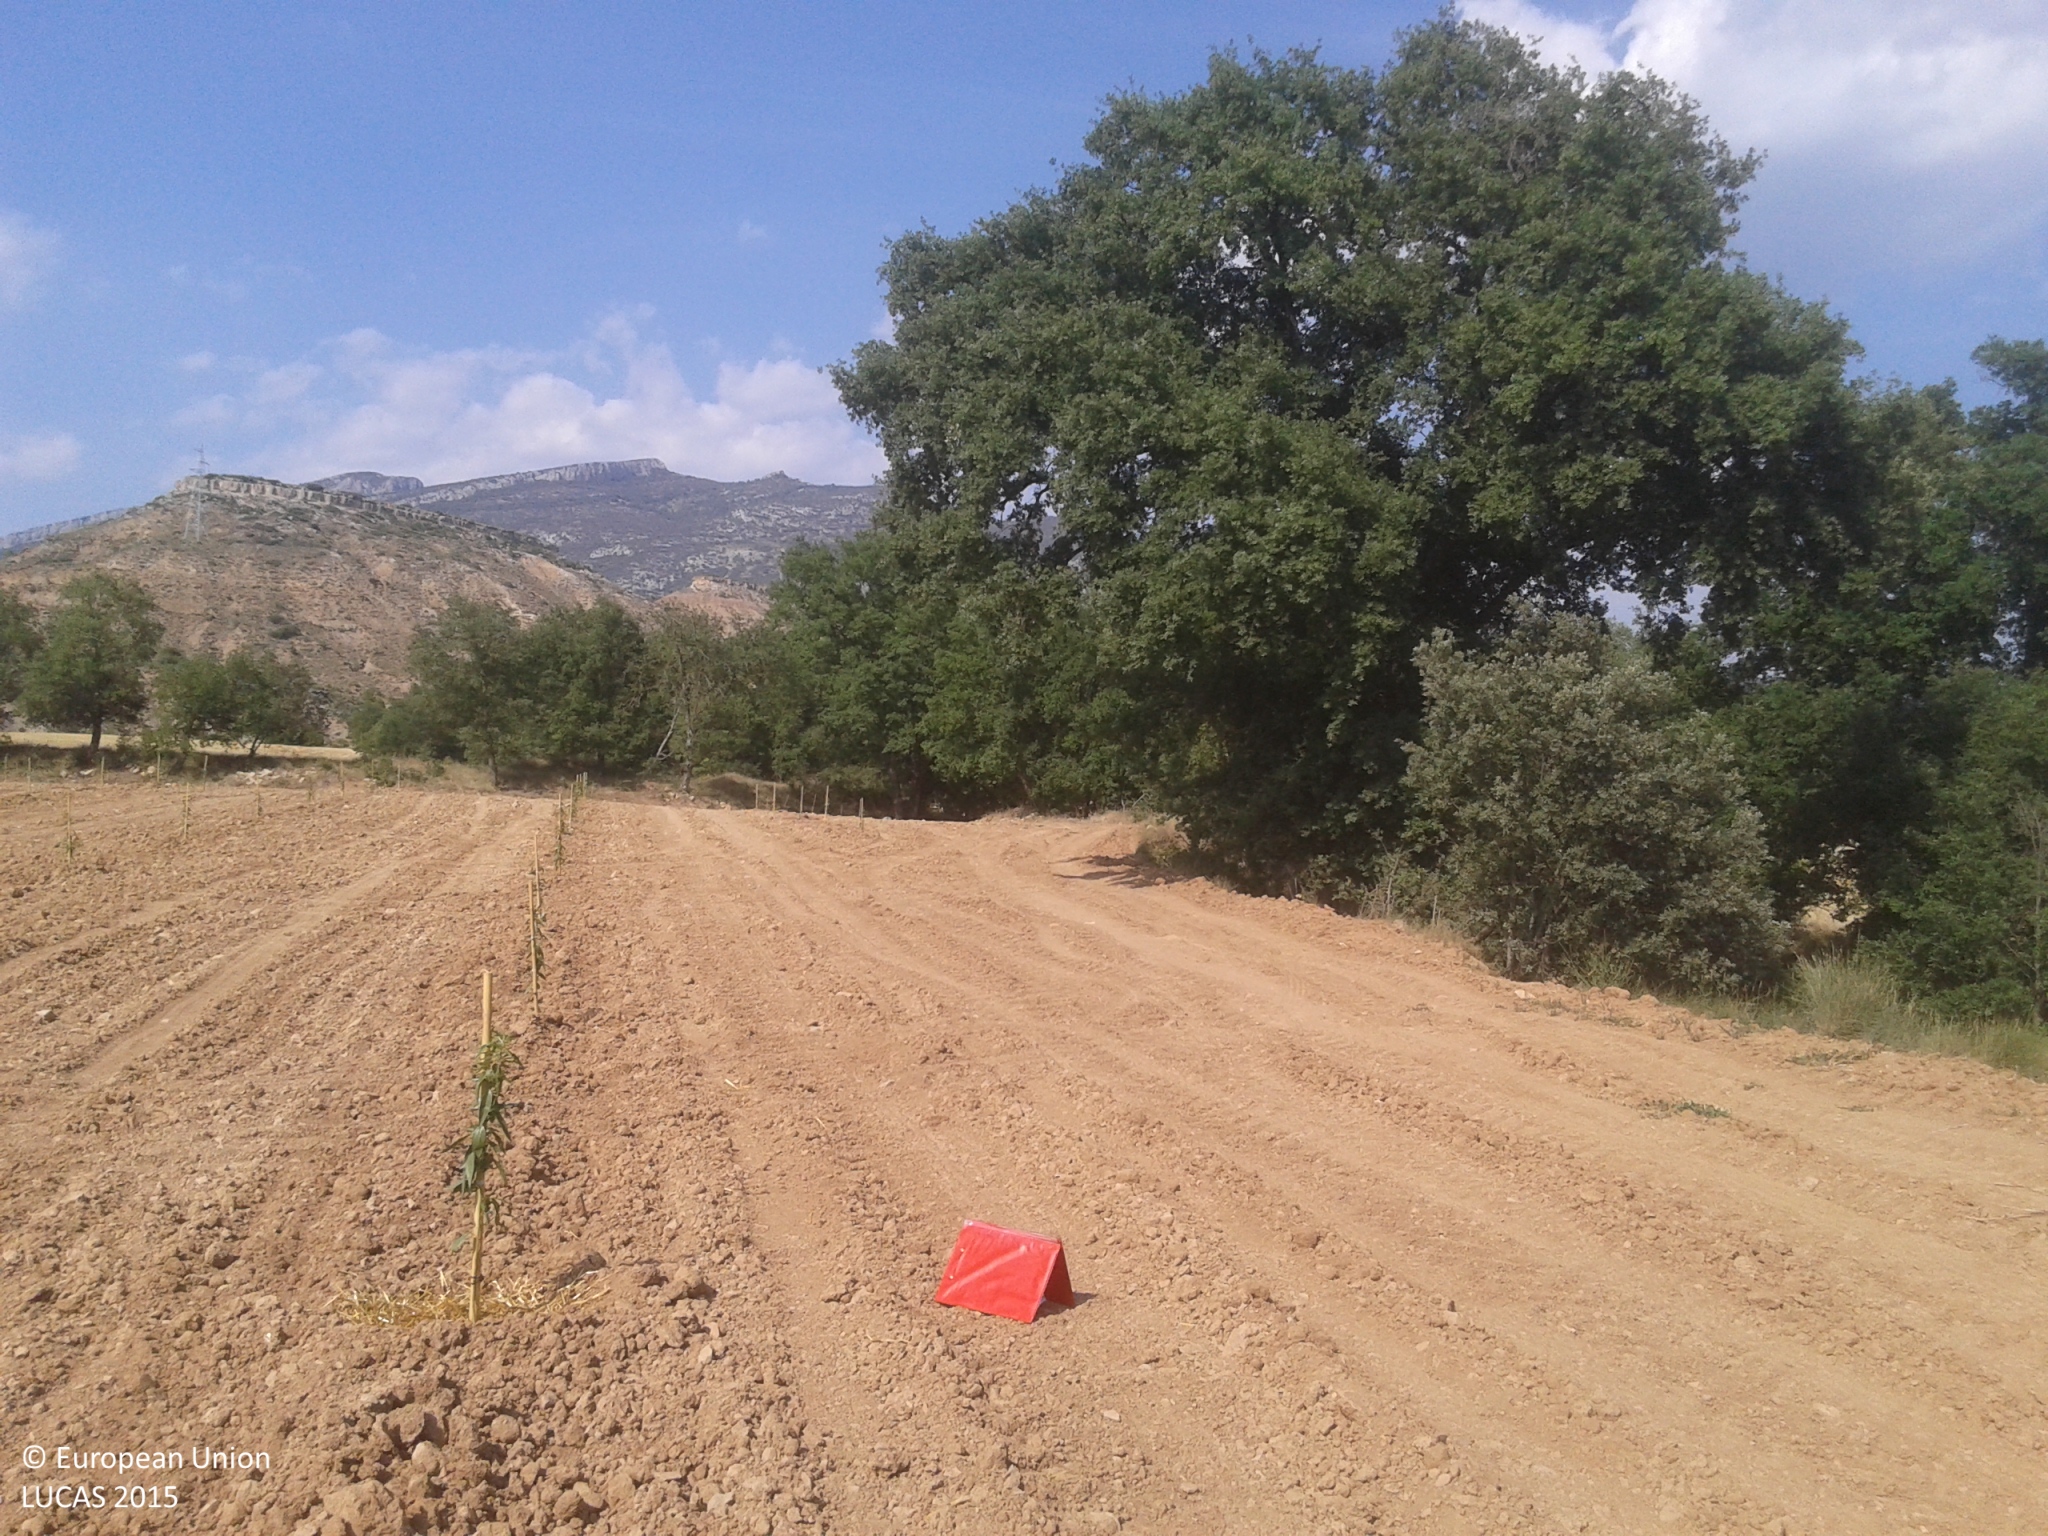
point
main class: Cropland
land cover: Nuts trees
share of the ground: < 10 %
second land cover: Other bare soil
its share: > 75 %
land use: Agriculture (excluding fallow land and kitchen gardens)
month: July
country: ES
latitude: 42.1475
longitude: 1.0431
